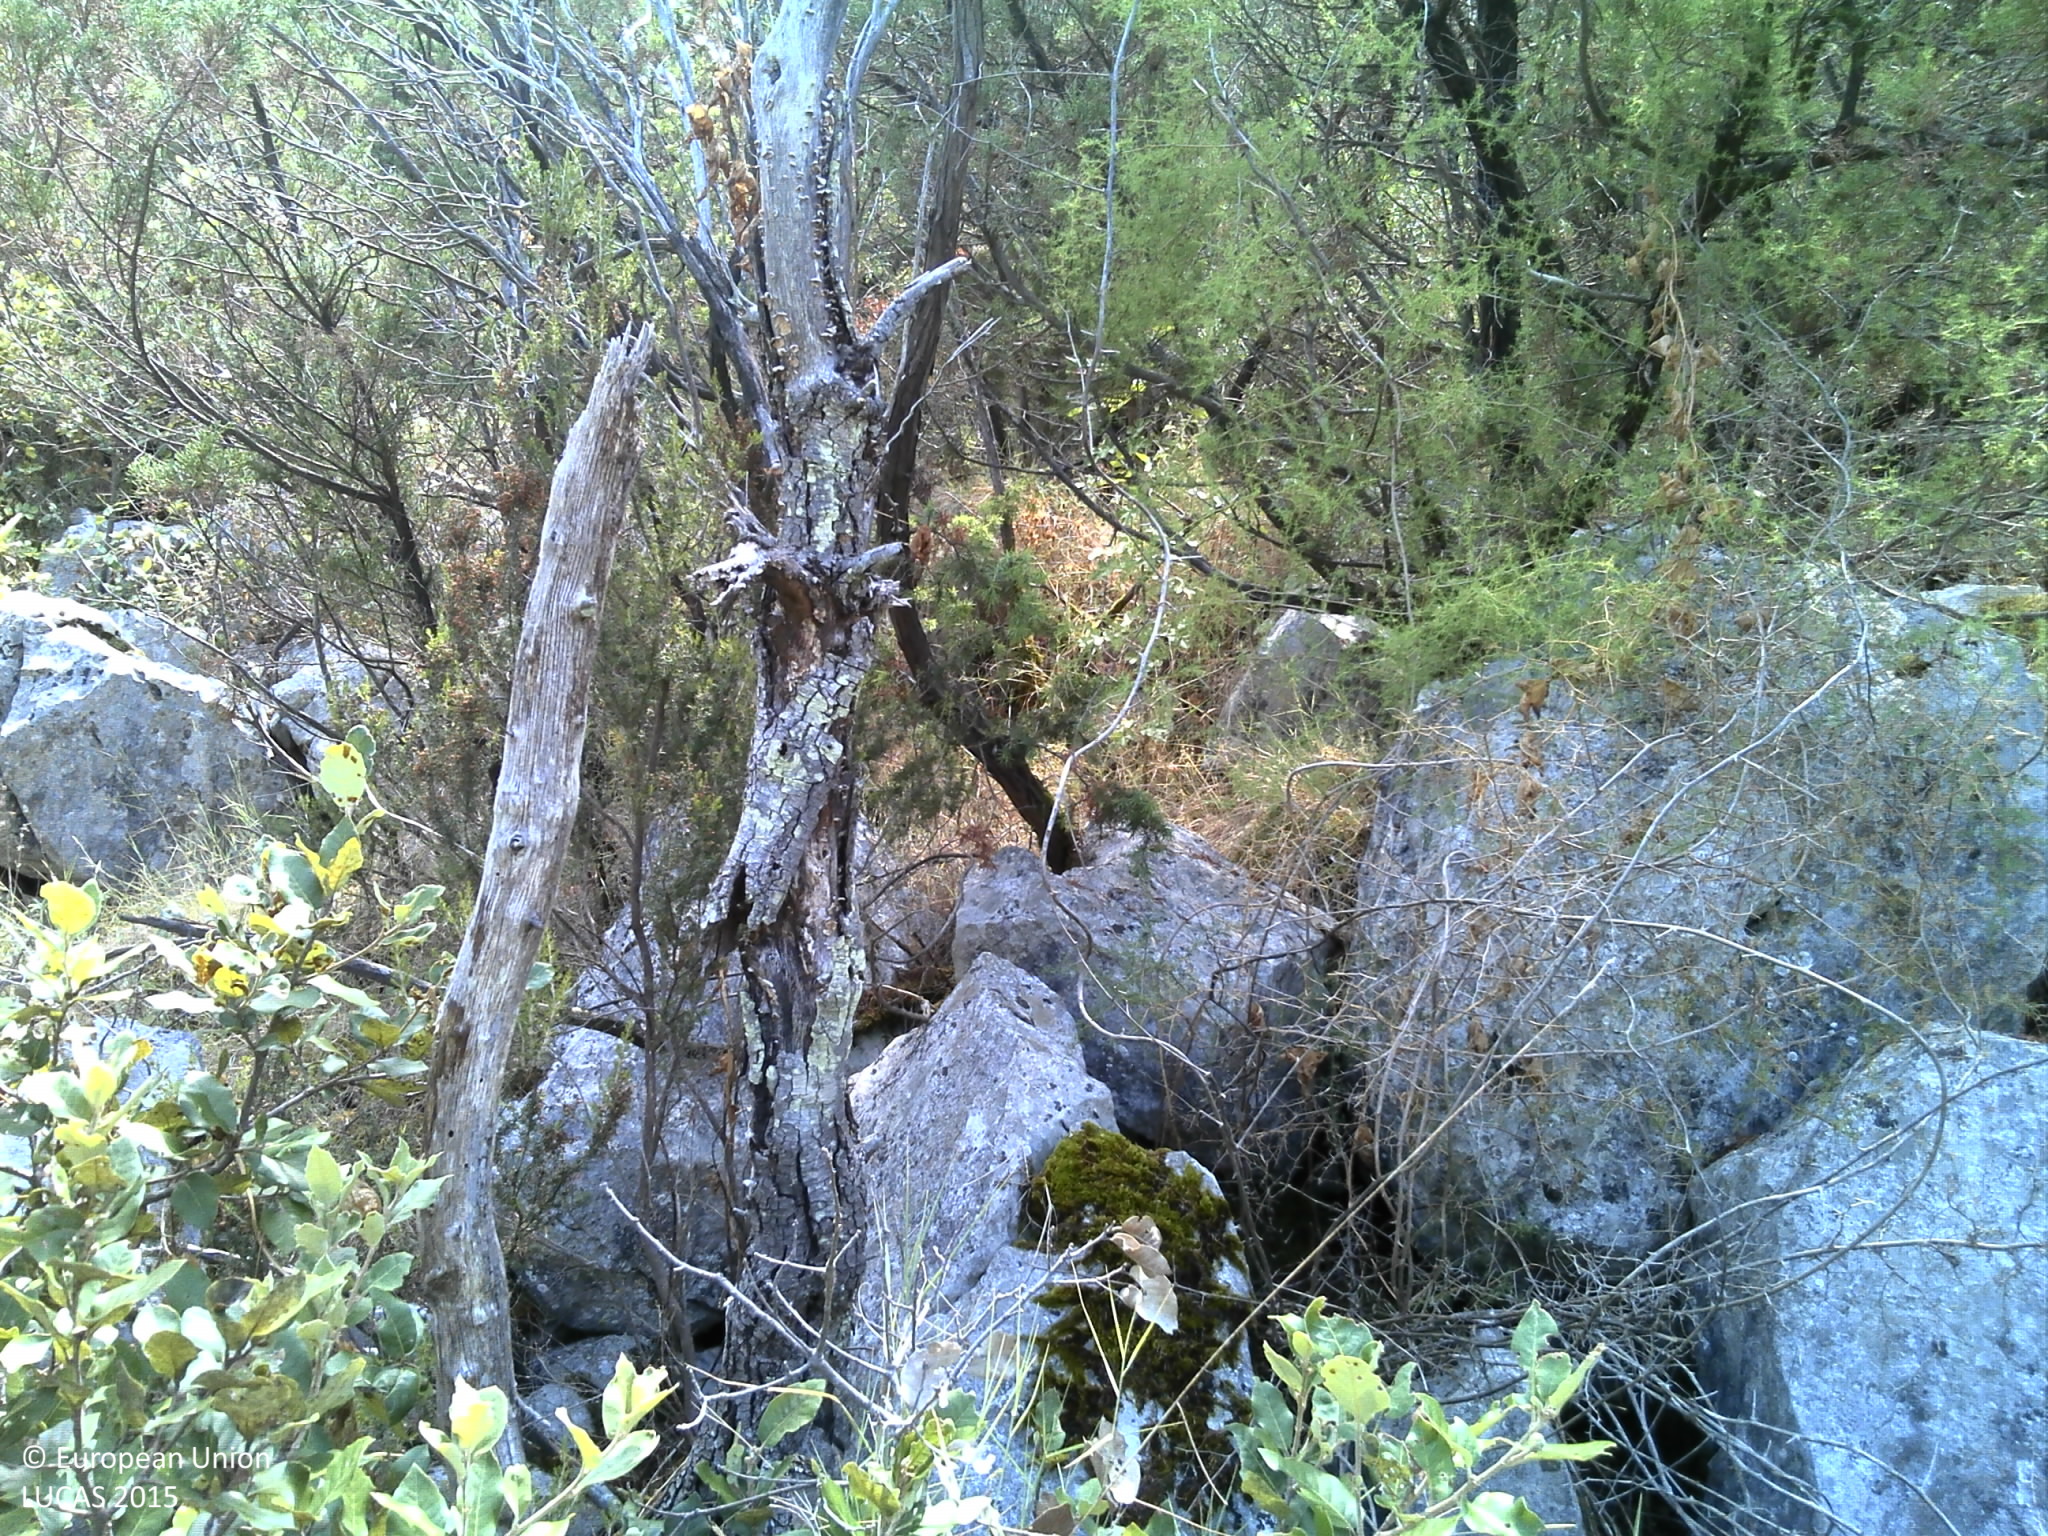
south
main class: Shrubland
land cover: Shrubland with sparse tree cover
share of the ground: > 75 %
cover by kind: shrubs 70 %, unconsolidated bare surface 10 %, broadleaved forest trees 5 %, herbaceous plants 5 %, lichens and mosses 5 %, consolidated bare surface 5 %
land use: Semi-natural and natural areas not in use
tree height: < 5 m
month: August
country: HR
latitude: 43.1357
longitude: 17.0098
